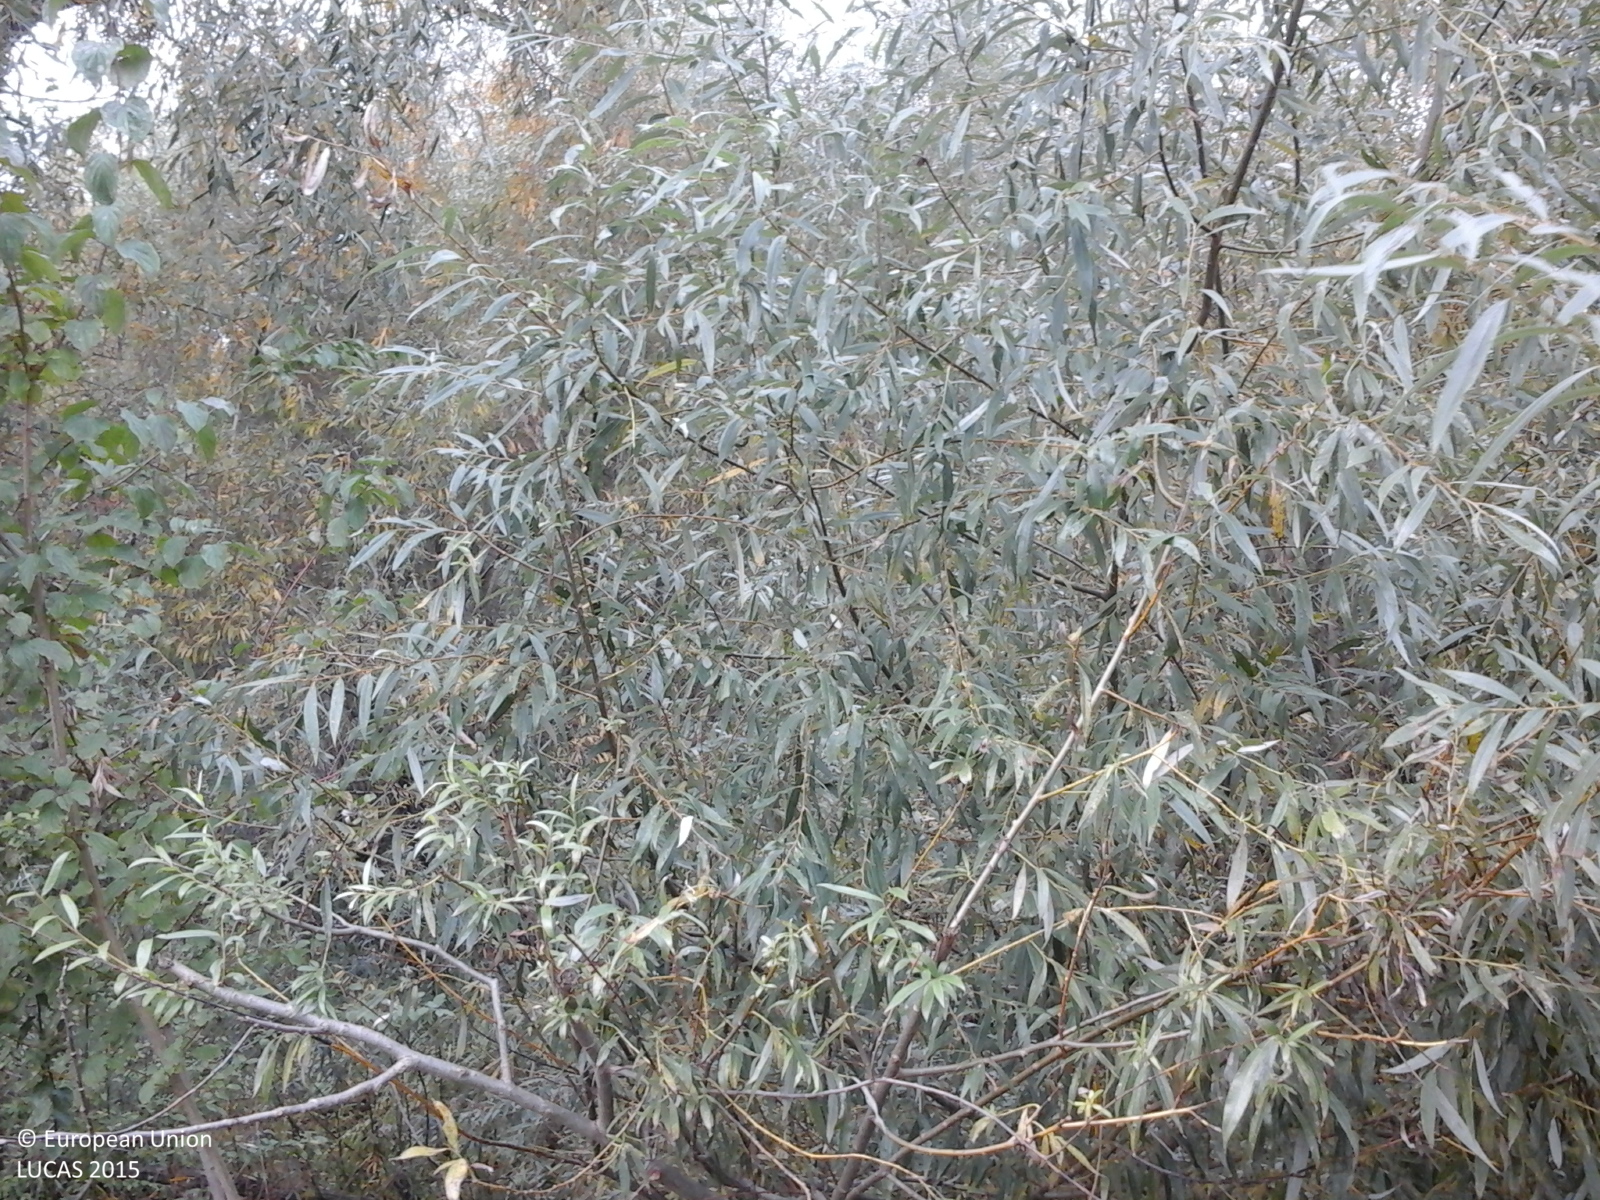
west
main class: Woodland
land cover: Broadleaved woodland
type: mesophytic deciduous forest
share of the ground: > 75 %
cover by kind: broadleaved forest trees 100 %
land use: Semi-natural and natural areas not in use
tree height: > 5 m
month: October
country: RO
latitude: 44.7660
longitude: 26.1427
